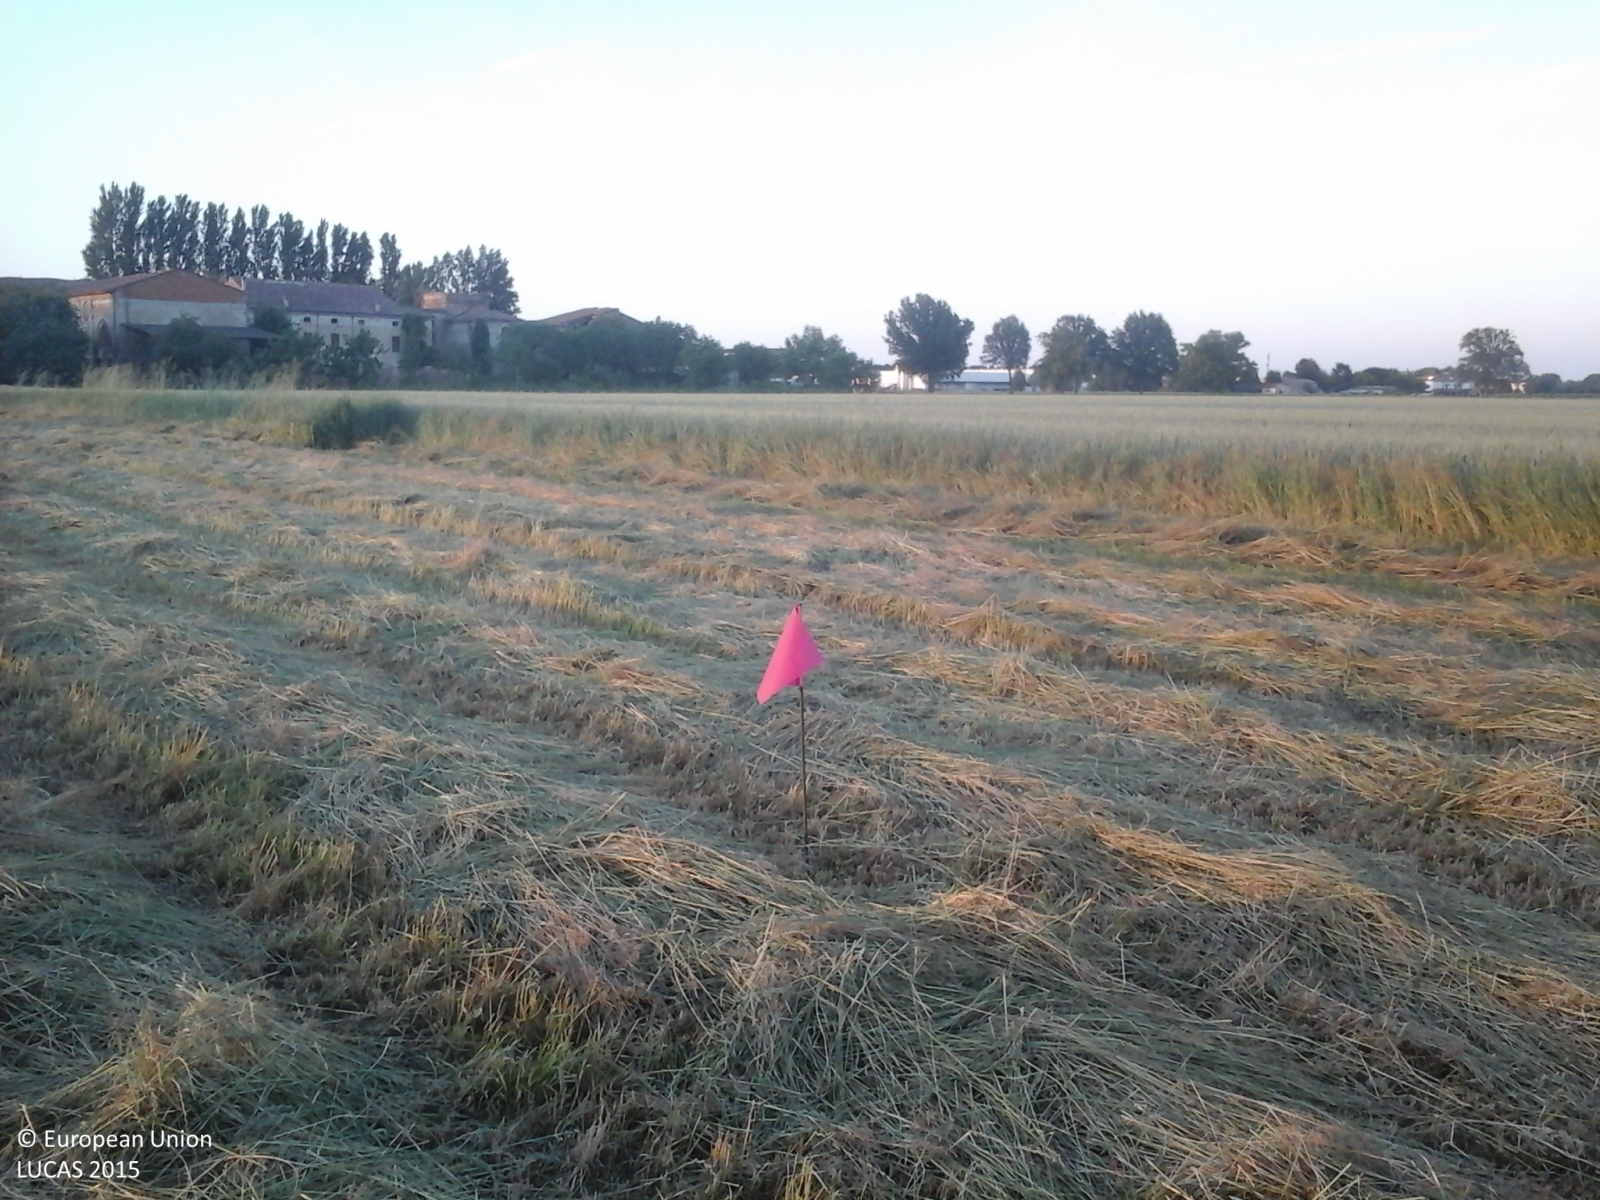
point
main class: Cropland
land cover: Temporary grasslands
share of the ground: > 75 %
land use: Agriculture (excluding fallow land and kitchen gardens)
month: May
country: IT
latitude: 44.9952
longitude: 10.9748
